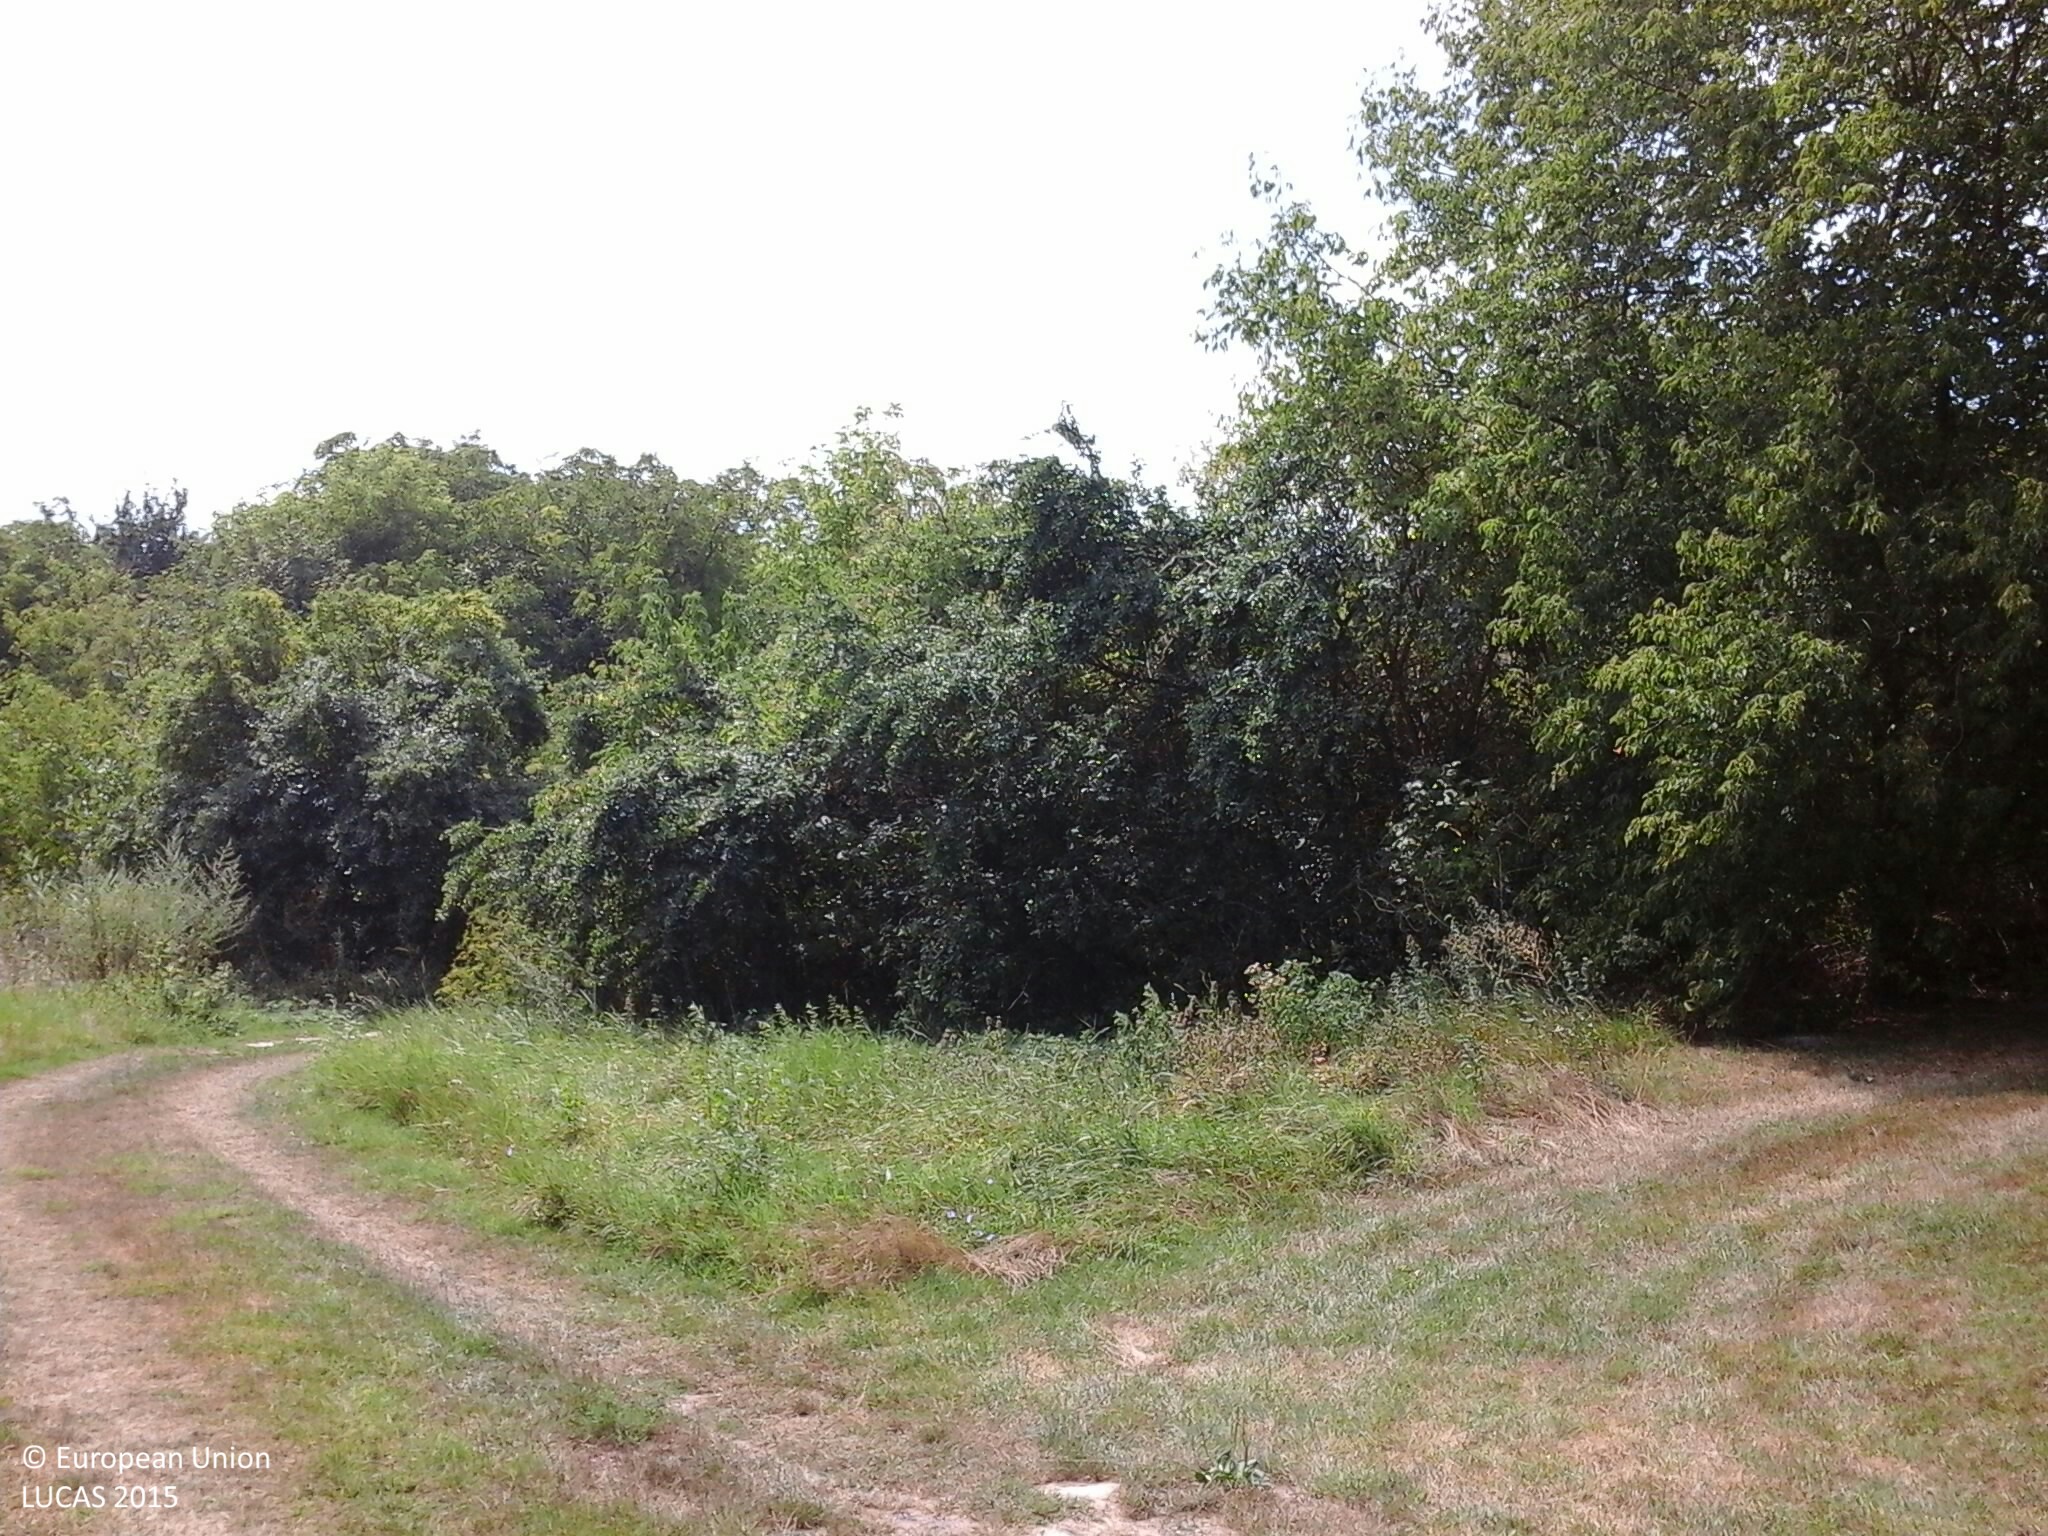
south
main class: Grassland
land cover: Grassland without tree/shrub cover
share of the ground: > 75 %
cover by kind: herbaceous plants 100 %
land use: Agriculture (excluding fallow land and kitchen gardens)
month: August
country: HU
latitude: 46.8975
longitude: 18.0554
